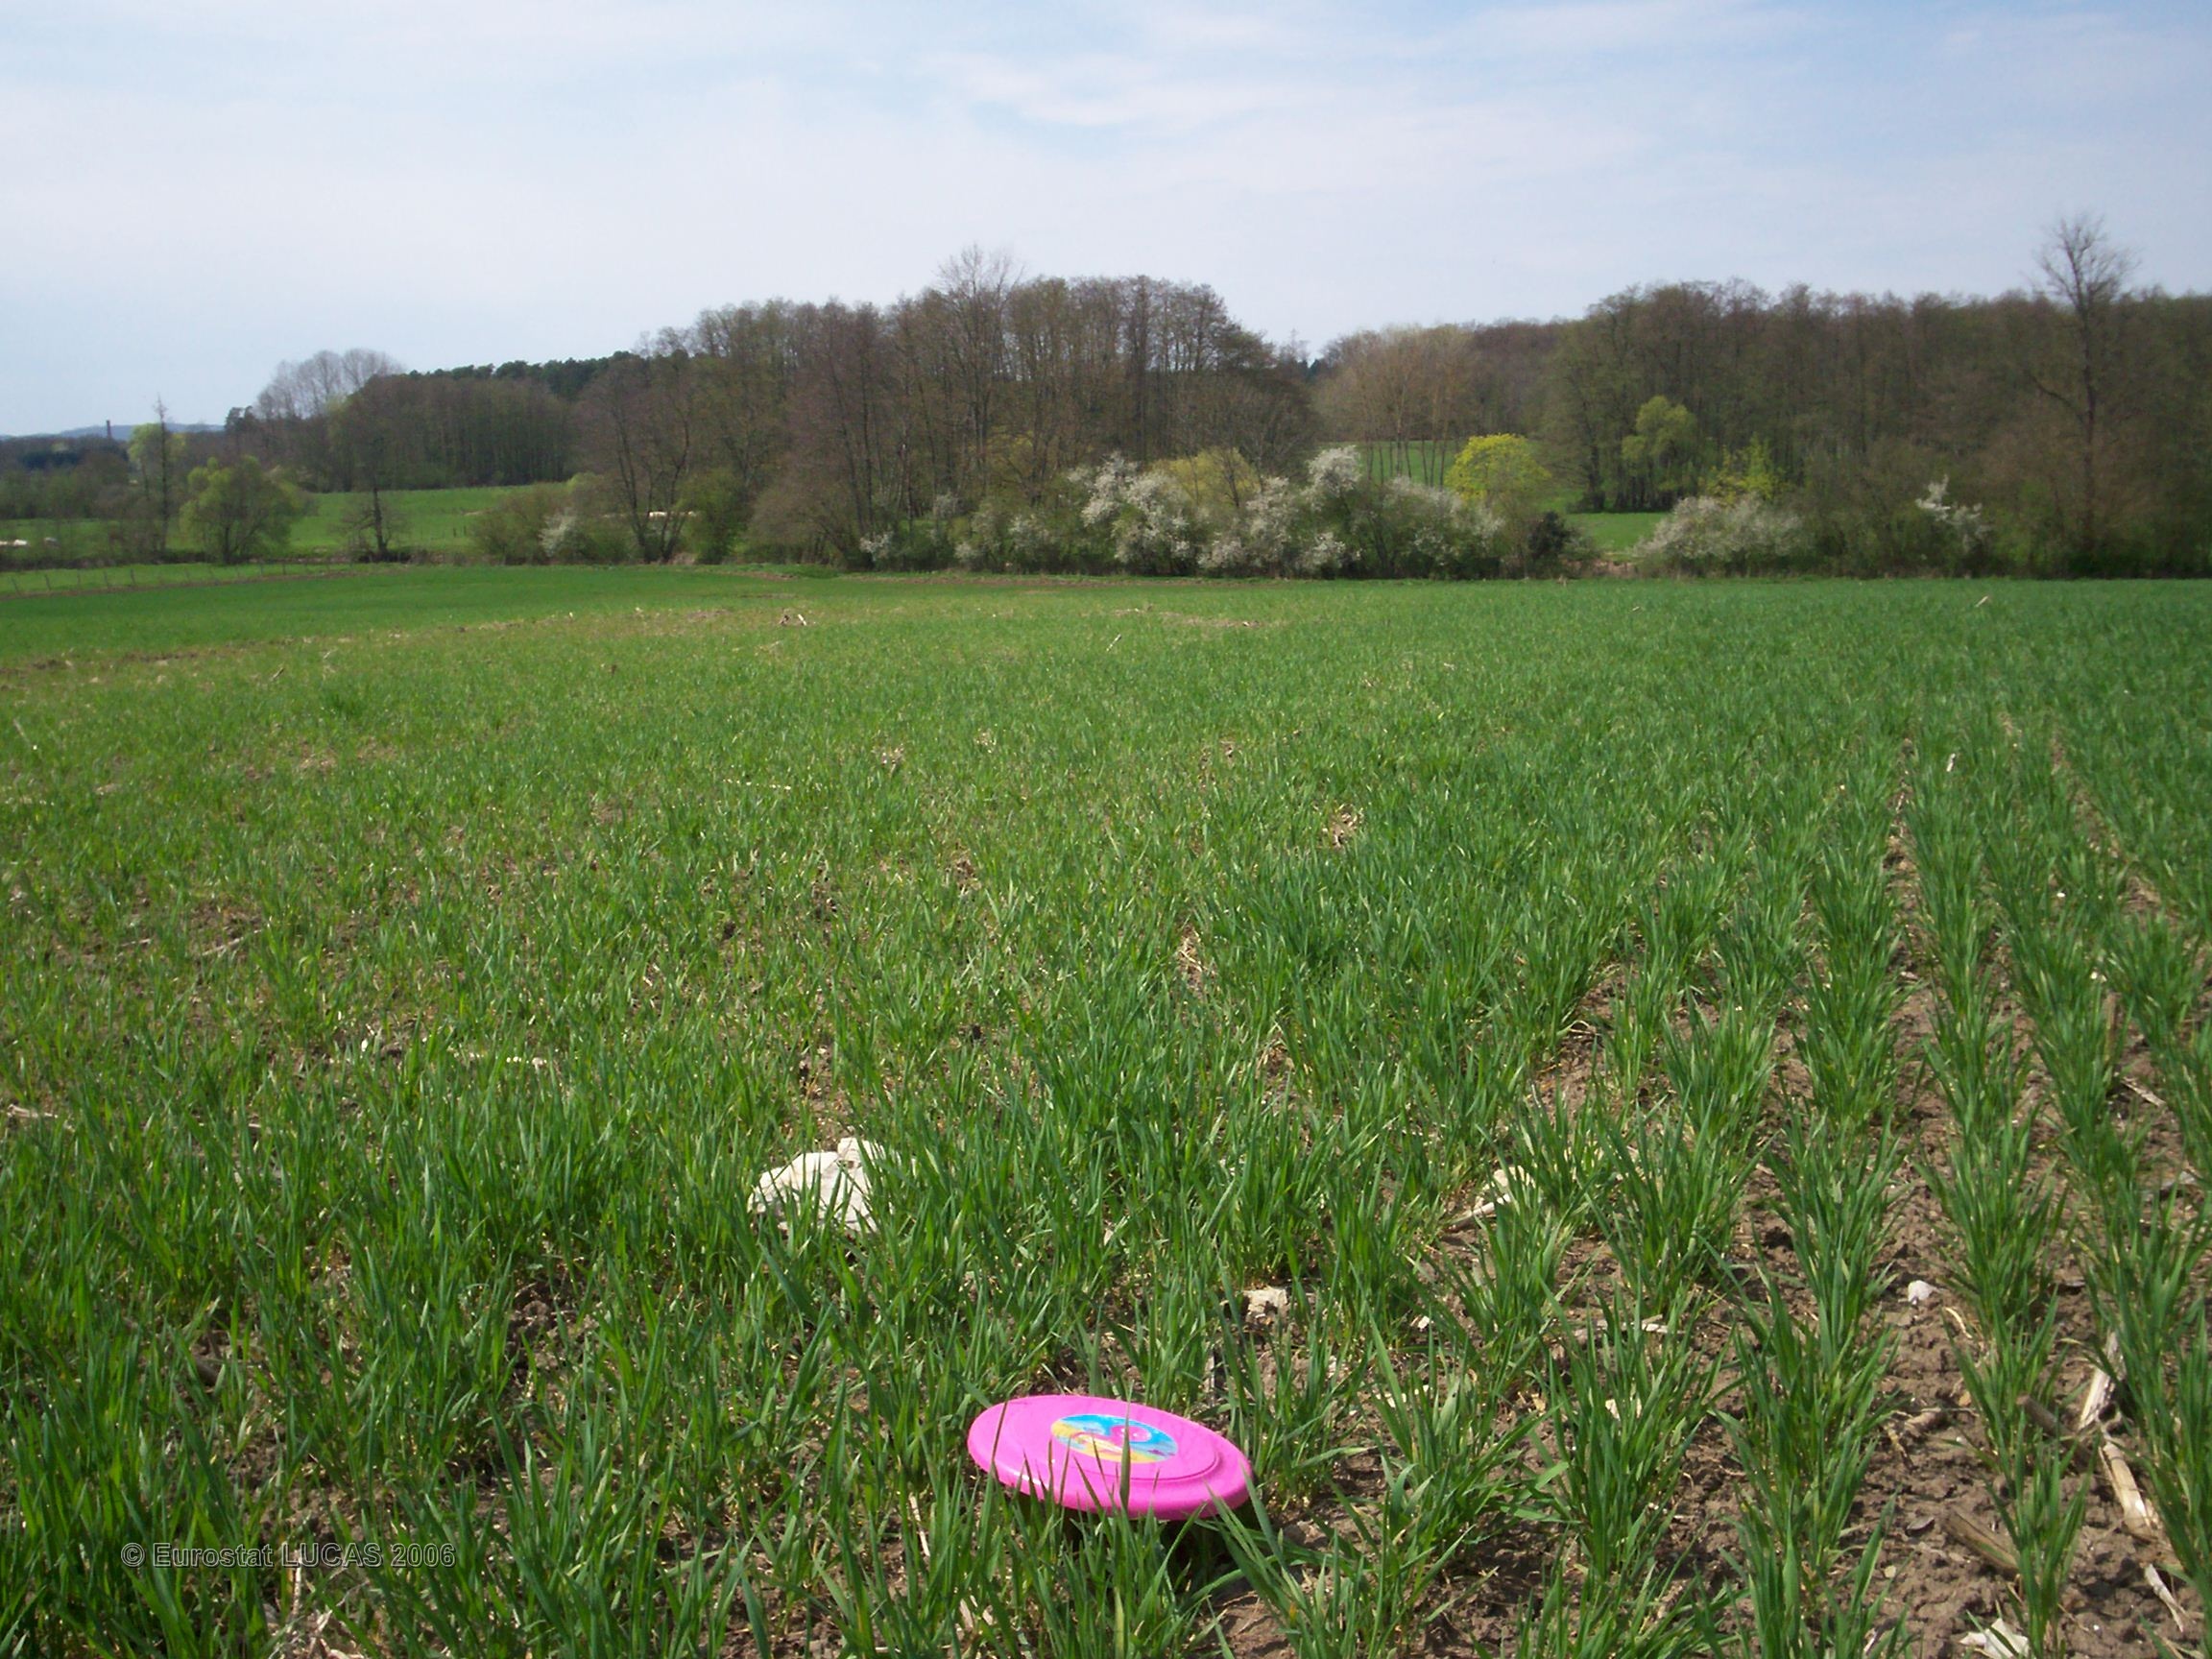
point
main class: Cropland
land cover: Common wheat
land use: Agriculture (excluding fallow land and kitchen gardens)
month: April
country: FR
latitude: 47.9367
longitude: 6.0518
